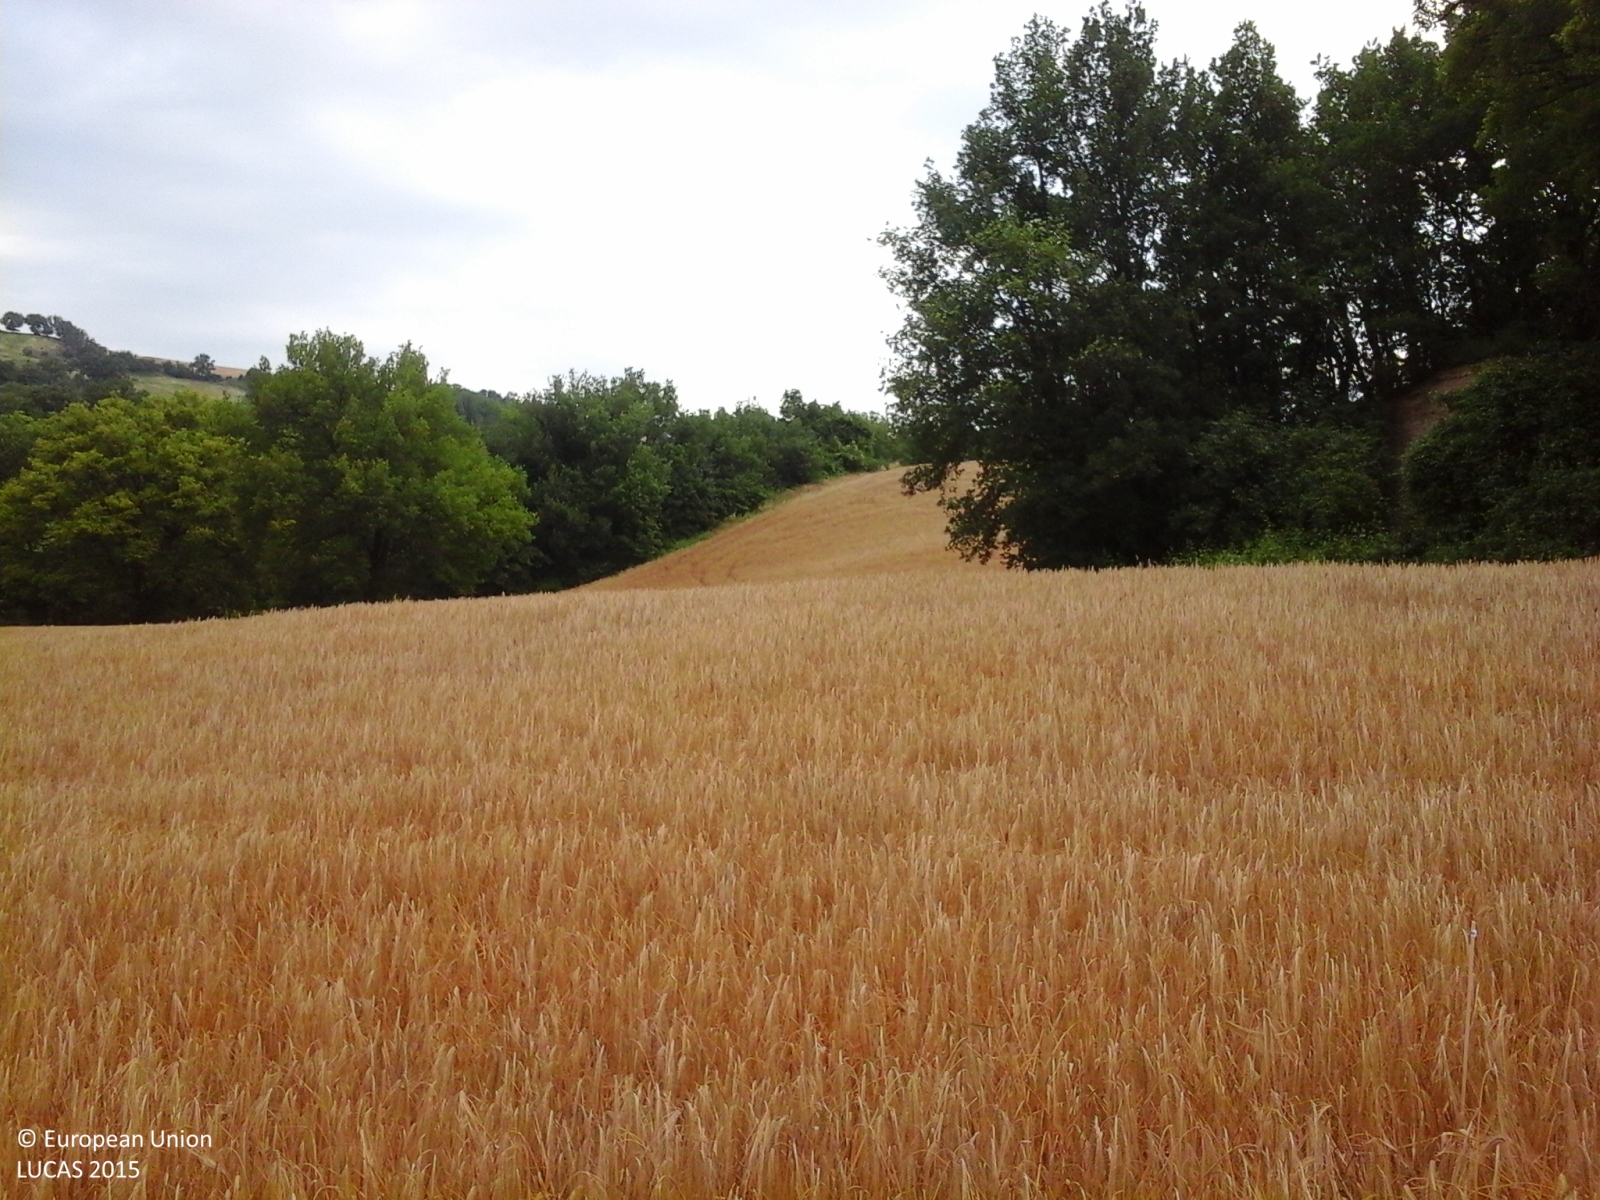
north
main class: Cropland
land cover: Barley
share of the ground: > 75 %
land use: Agriculture (excluding fallow land and kitchen gardens)
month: June
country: IT
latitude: 43.1981
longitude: 13.2525
